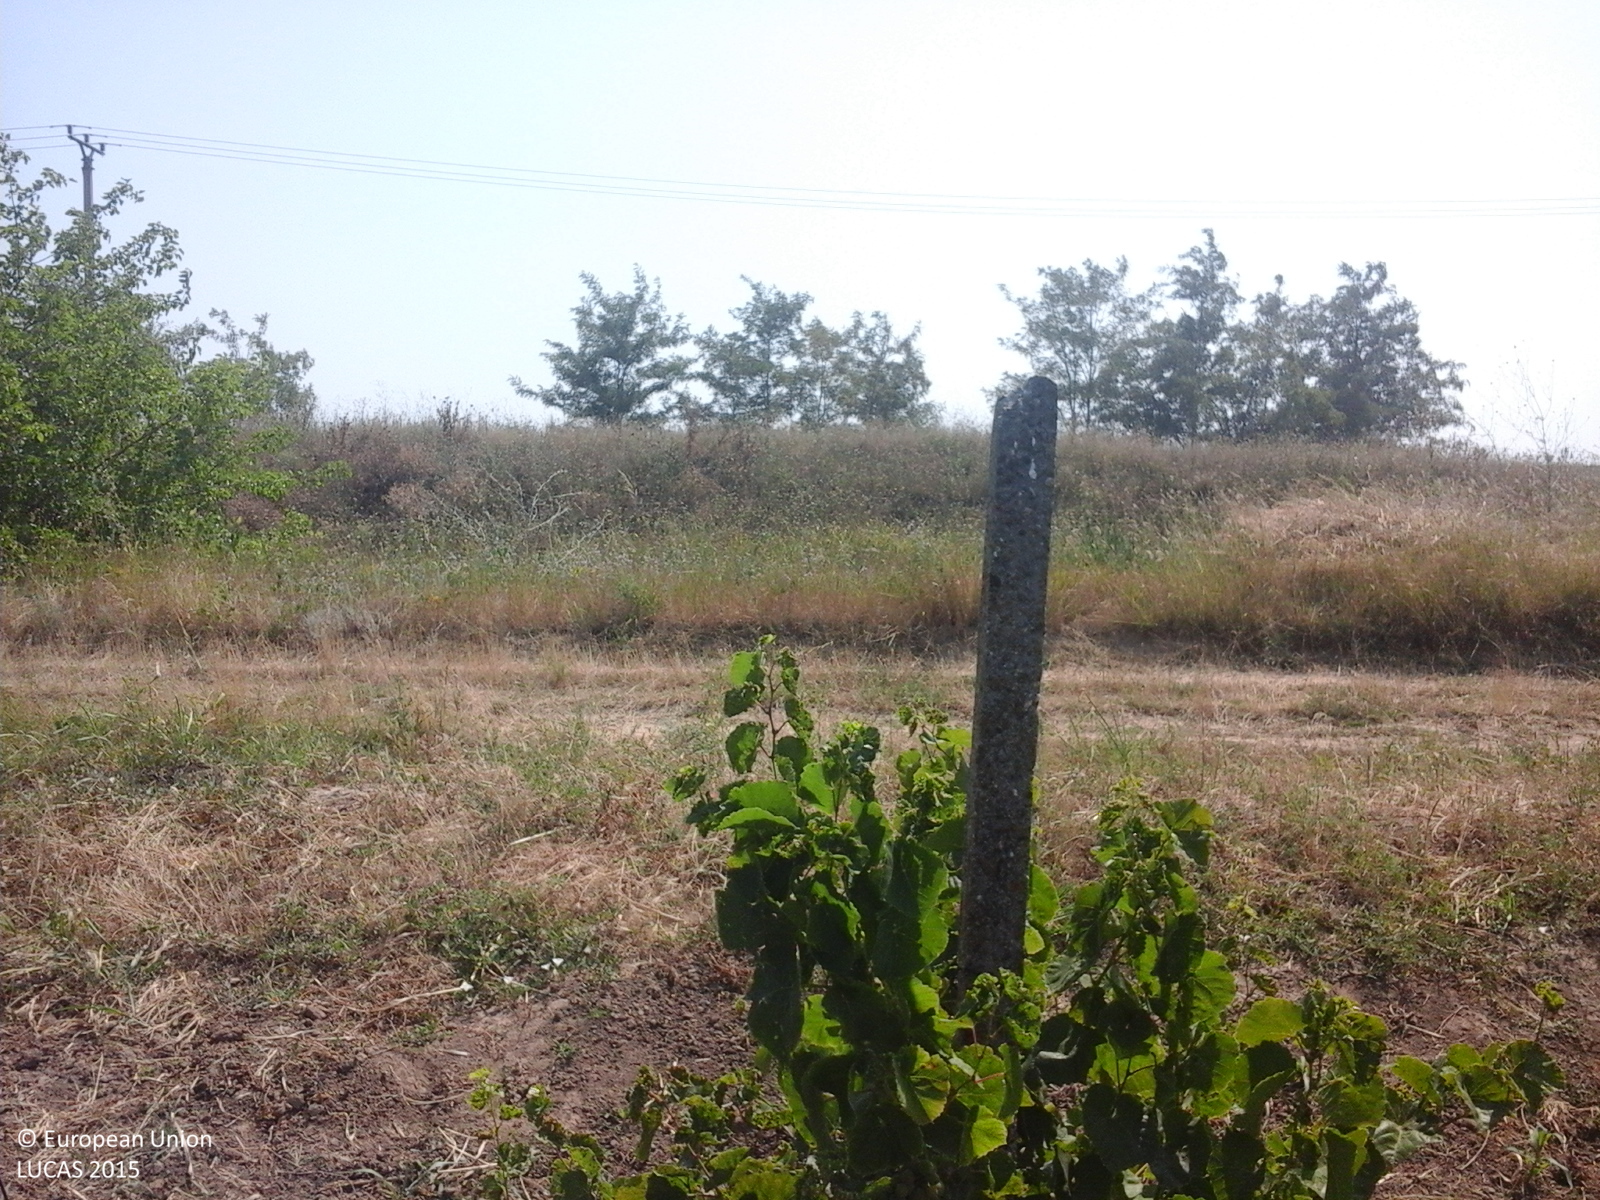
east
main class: Cropland
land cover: Vineyards
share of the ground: > 75 %
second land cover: Other bare soil
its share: > 75 %
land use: Agriculture (excluding fallow land and kitchen gardens)
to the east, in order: Vineyards; Other bare soil; Tracks; Grass margins; Ditches and canals; Grass margins; Tracks; Grass margins; Lines of trees; Electric lines; Ditches and canals; Other bare soil
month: July
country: RO
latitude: 45.5302
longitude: 27.8738
